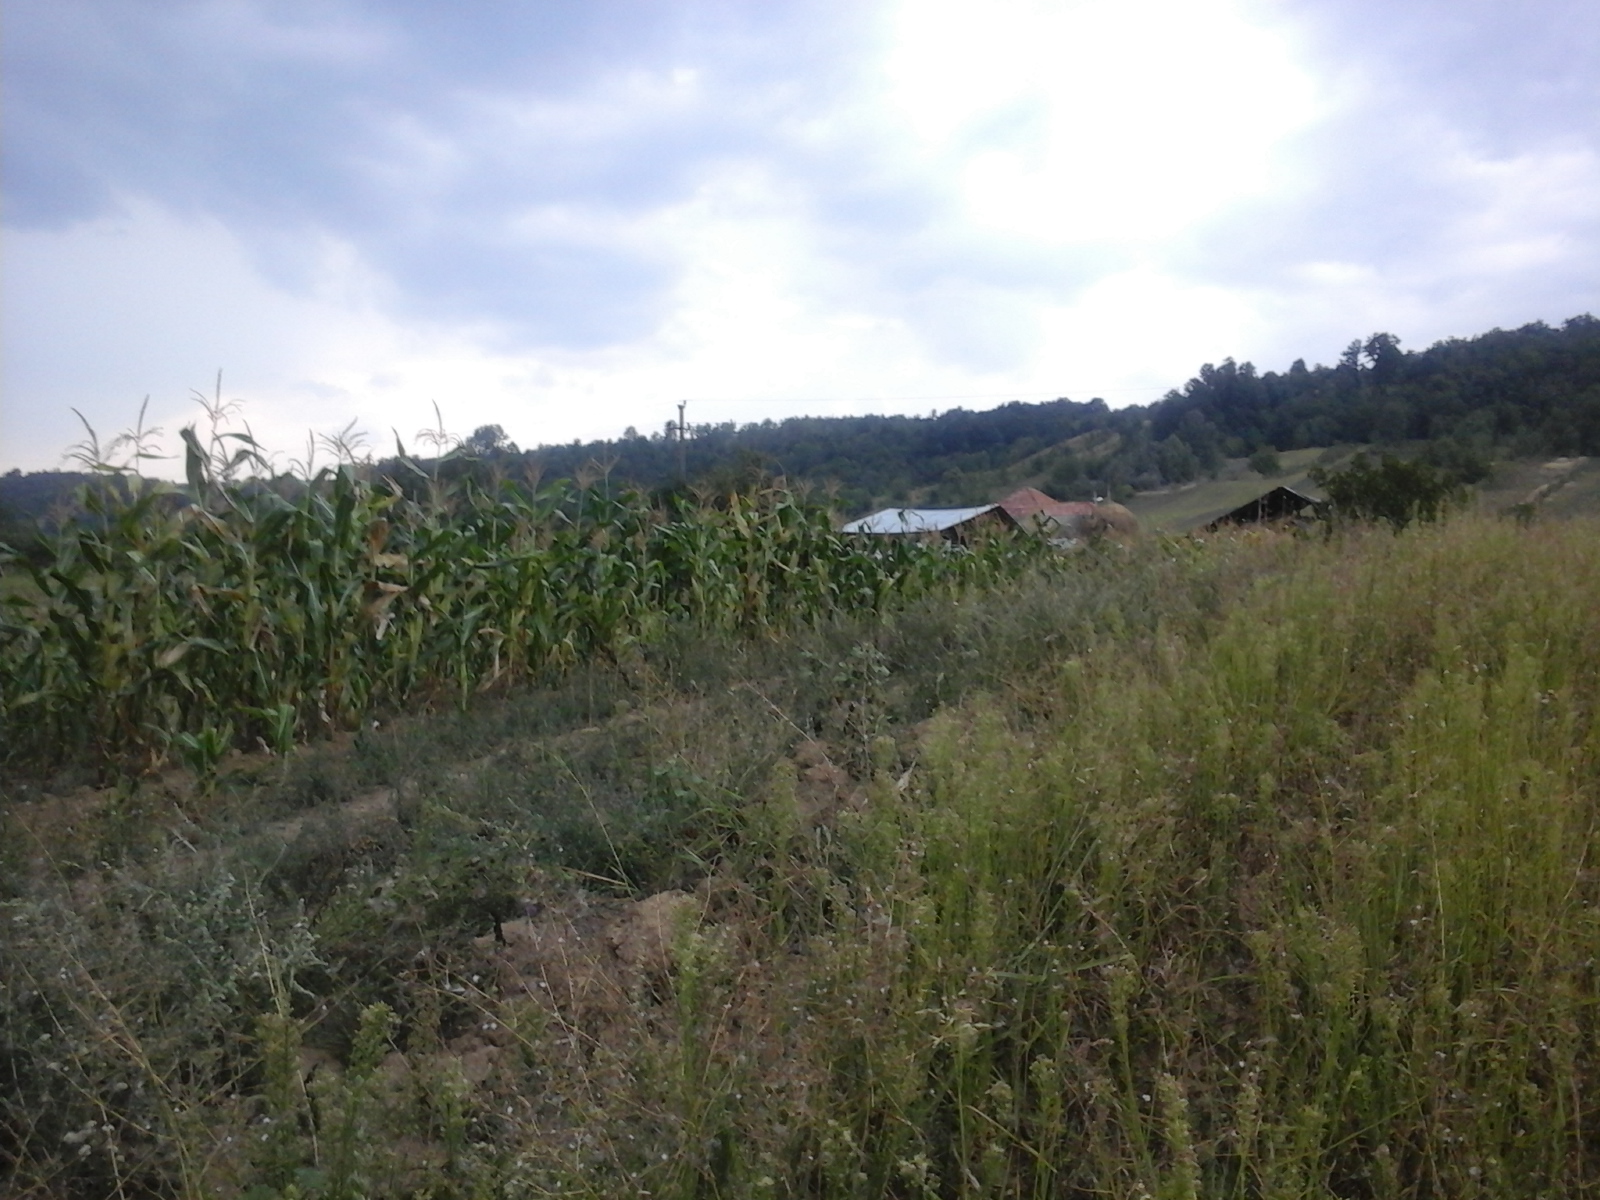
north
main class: Grassland
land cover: Spontaneously vegetated surfaces
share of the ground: > 75 %
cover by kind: herbaceous plants 100 %
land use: Agriculture (excluding fallow land and kitchen gardens)
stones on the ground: < 10 %
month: August
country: RO
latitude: 44.6369
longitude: 23.3263
